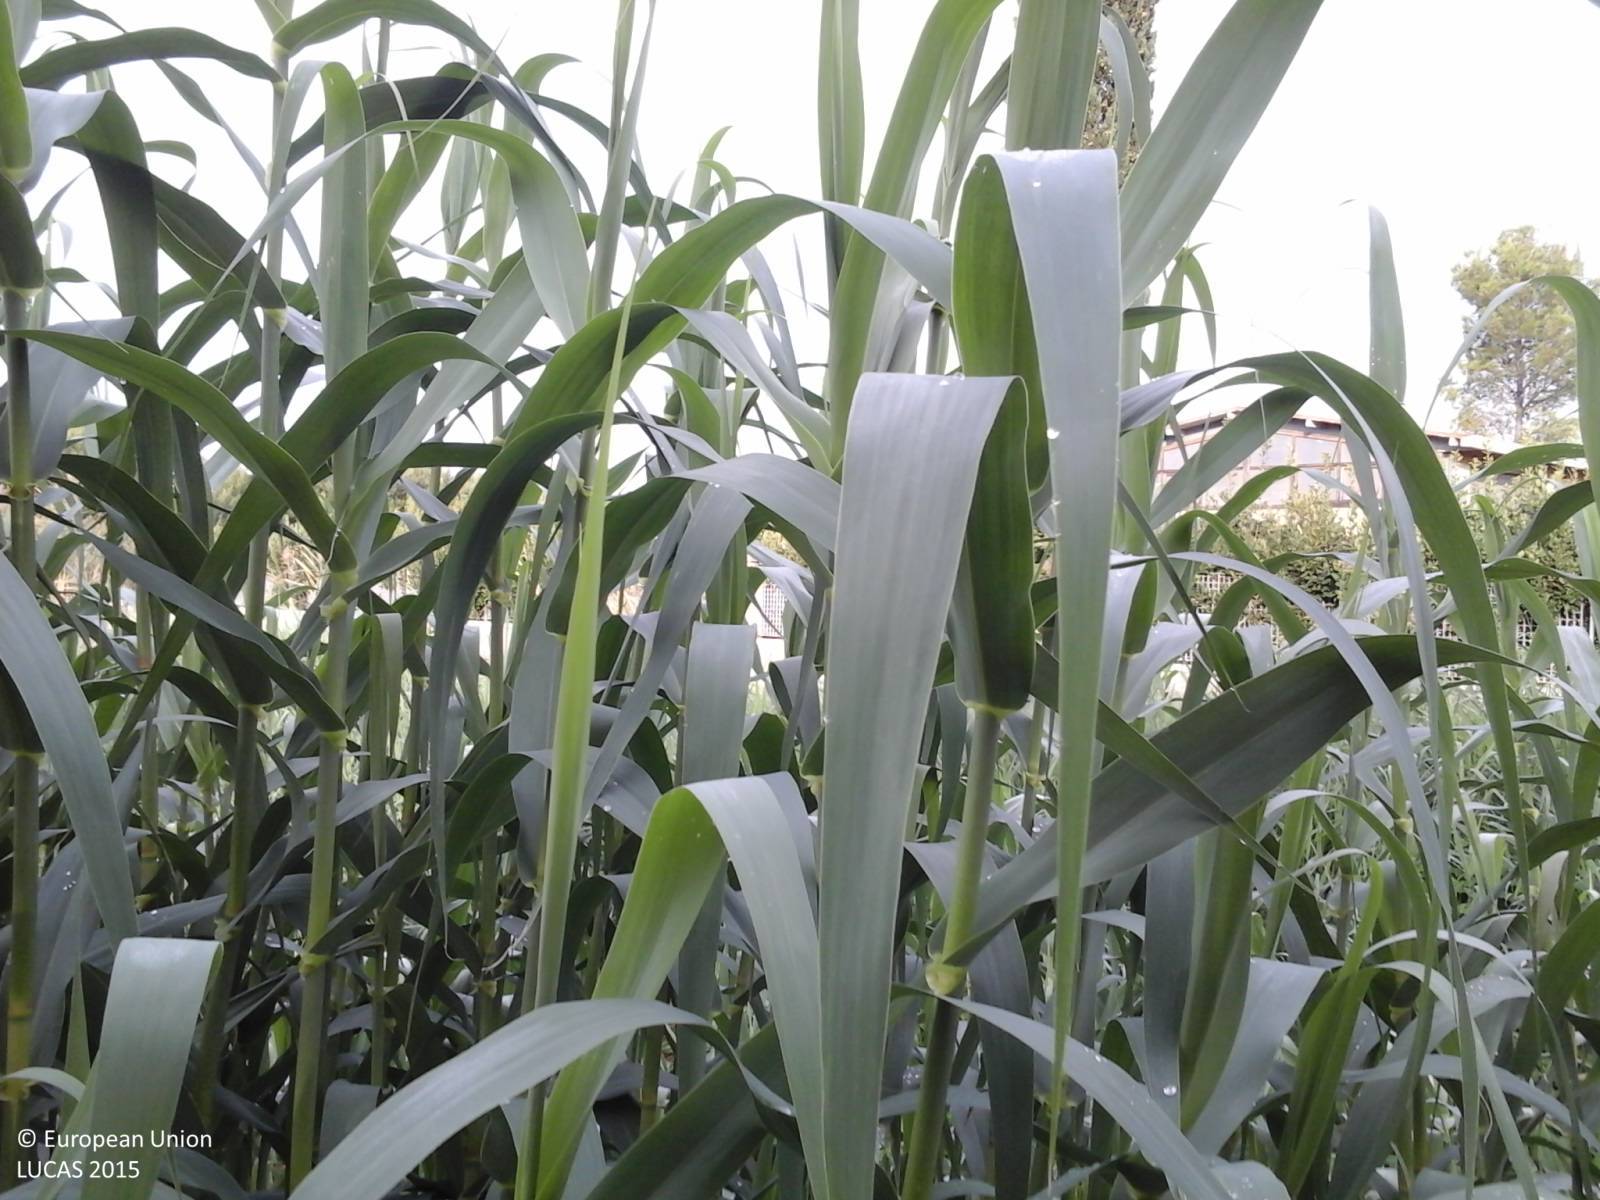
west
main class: Grassland
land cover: Grassland without tree/shrub cover
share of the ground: 25 - 50 %
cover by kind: herbaceous plants 100 %
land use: Semi-natural and natural areas not in use
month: October
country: IT
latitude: 43.3028
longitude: 10.5039
